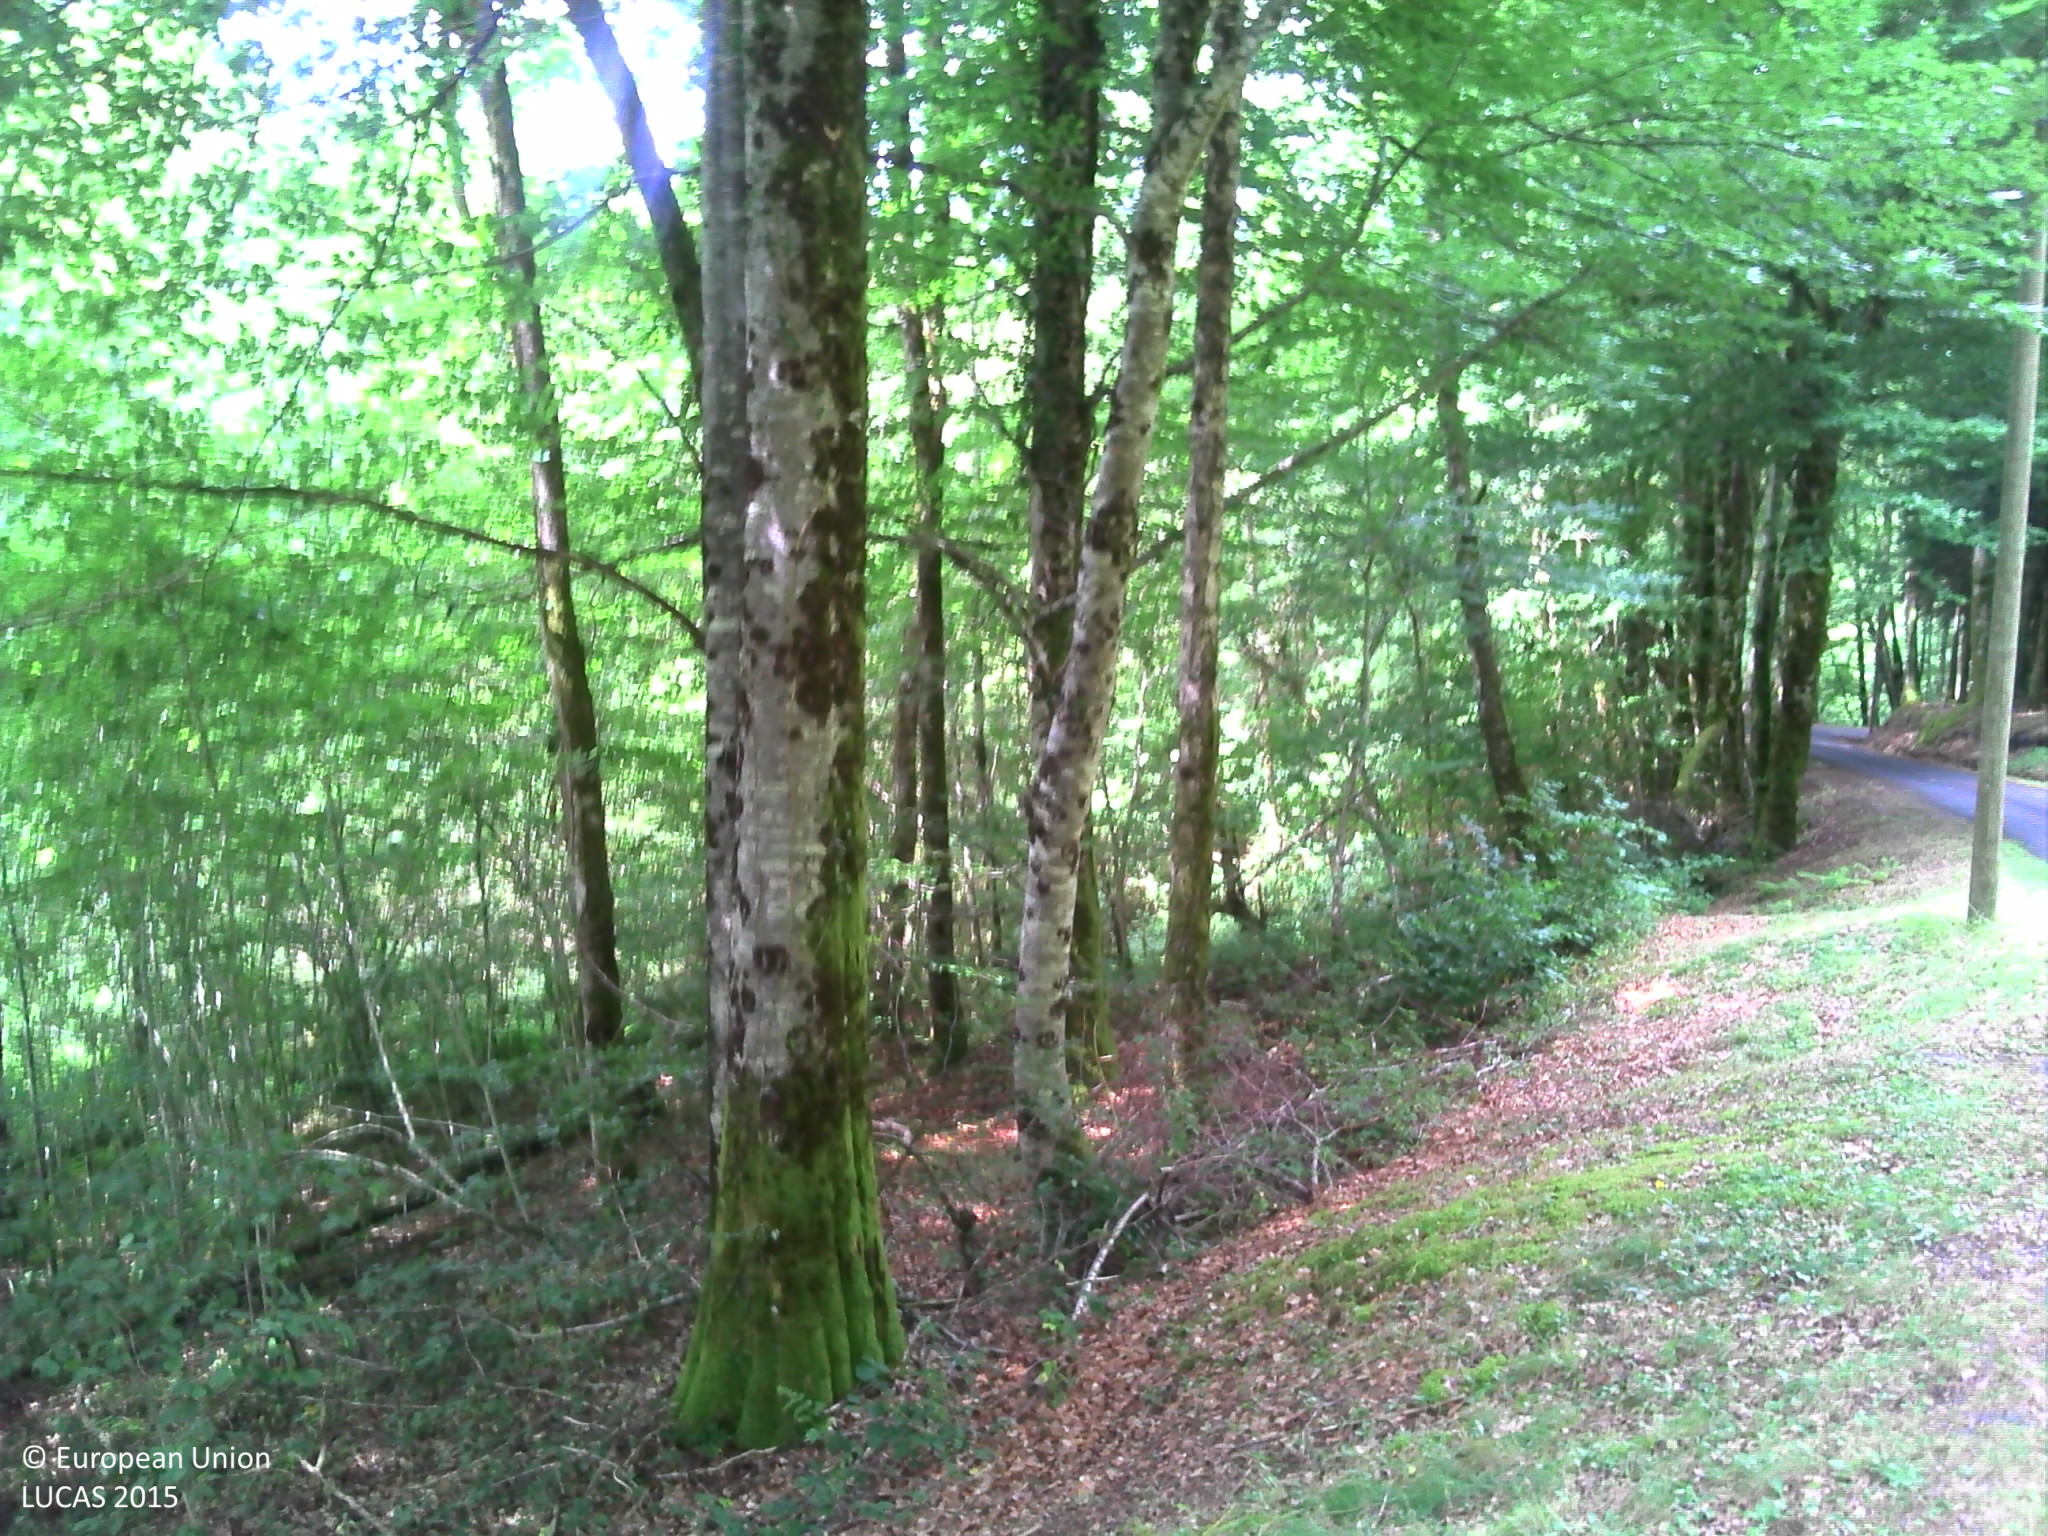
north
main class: Woodland
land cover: Broadleaved woodland
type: beech forest
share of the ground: > 75 %
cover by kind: broadleaved forest trees 70 %, herbaceous plants 25 %, lichens and mosses 5 %
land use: Forestry
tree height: > 5 m
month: July
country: FR
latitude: 45.6593
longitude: 1.8453
